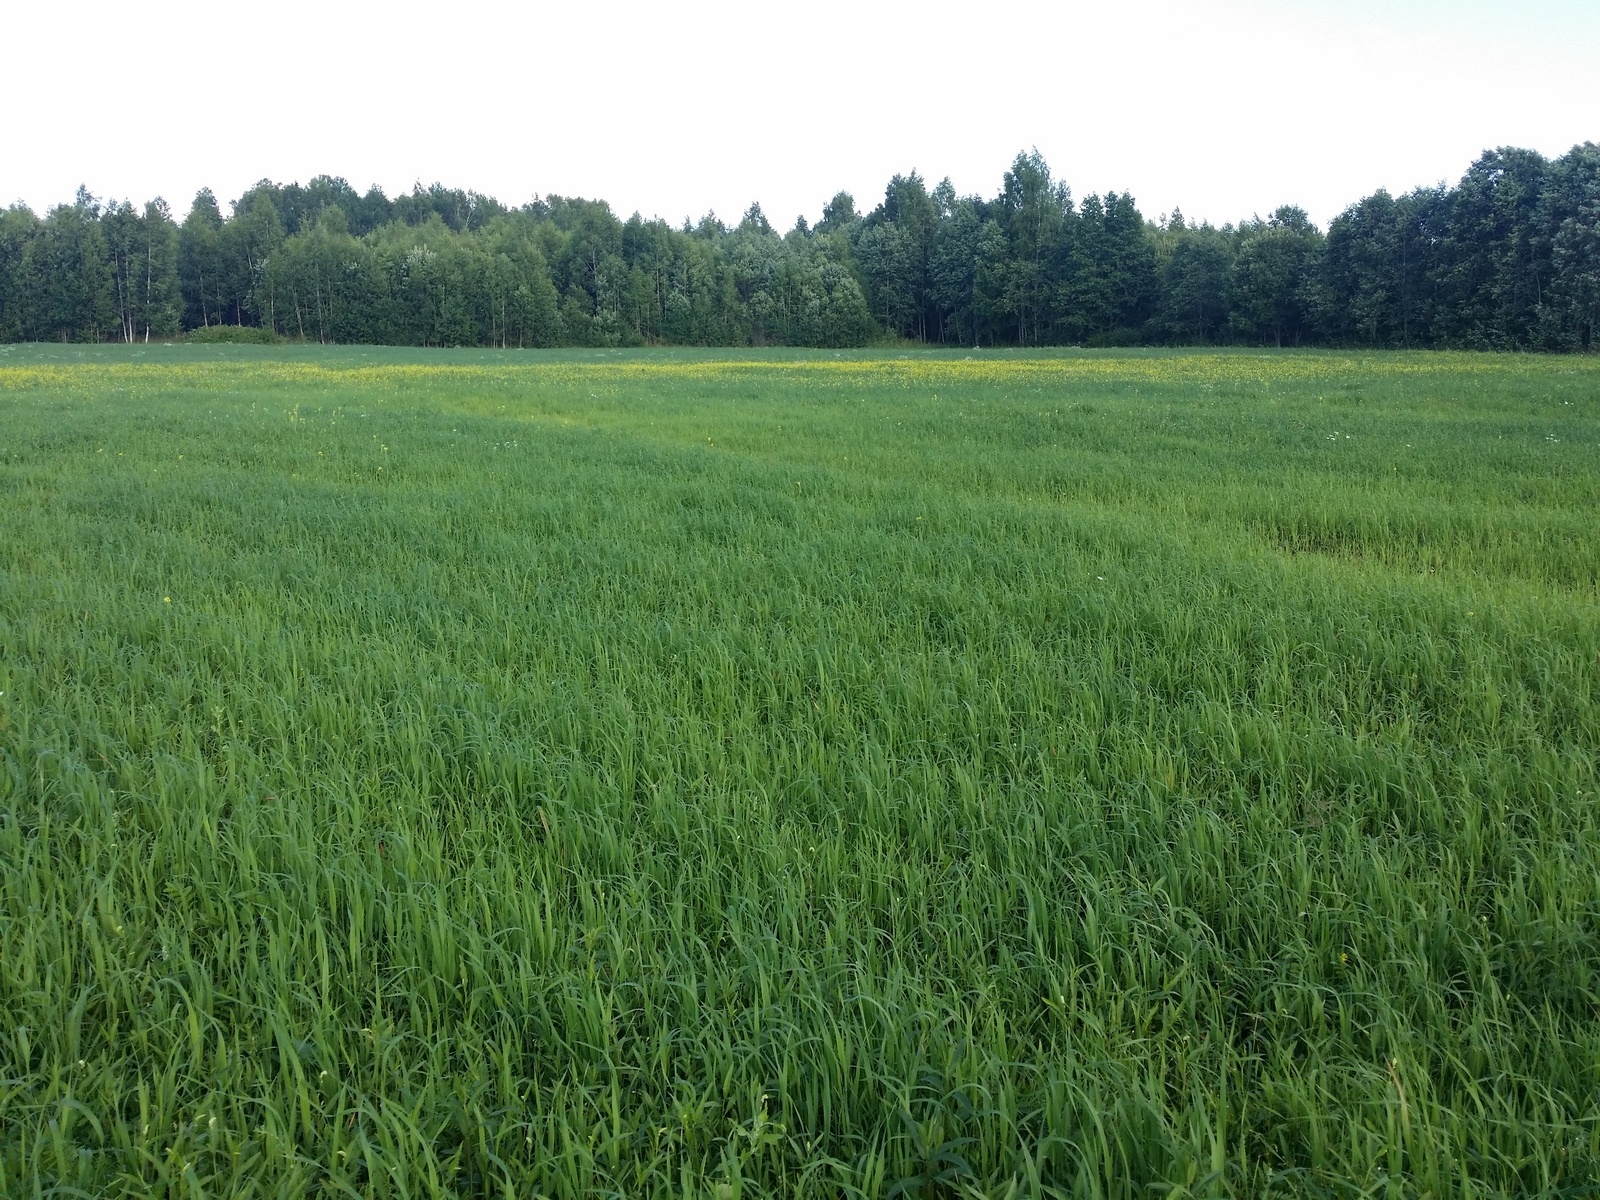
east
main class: Grassland
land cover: Grassland without tree/shrub cover
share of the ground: > 75 %
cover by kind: herbaceous plants 100 %
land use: Agriculture (excluding fallow land and kitchen gardens)
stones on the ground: < 10 %
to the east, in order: Grassland without tree/shrub cover; Broadleaved woodland; Ditches and canals; Broadleaved woodland
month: July
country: LV
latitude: 57.2209
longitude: 27.2414
